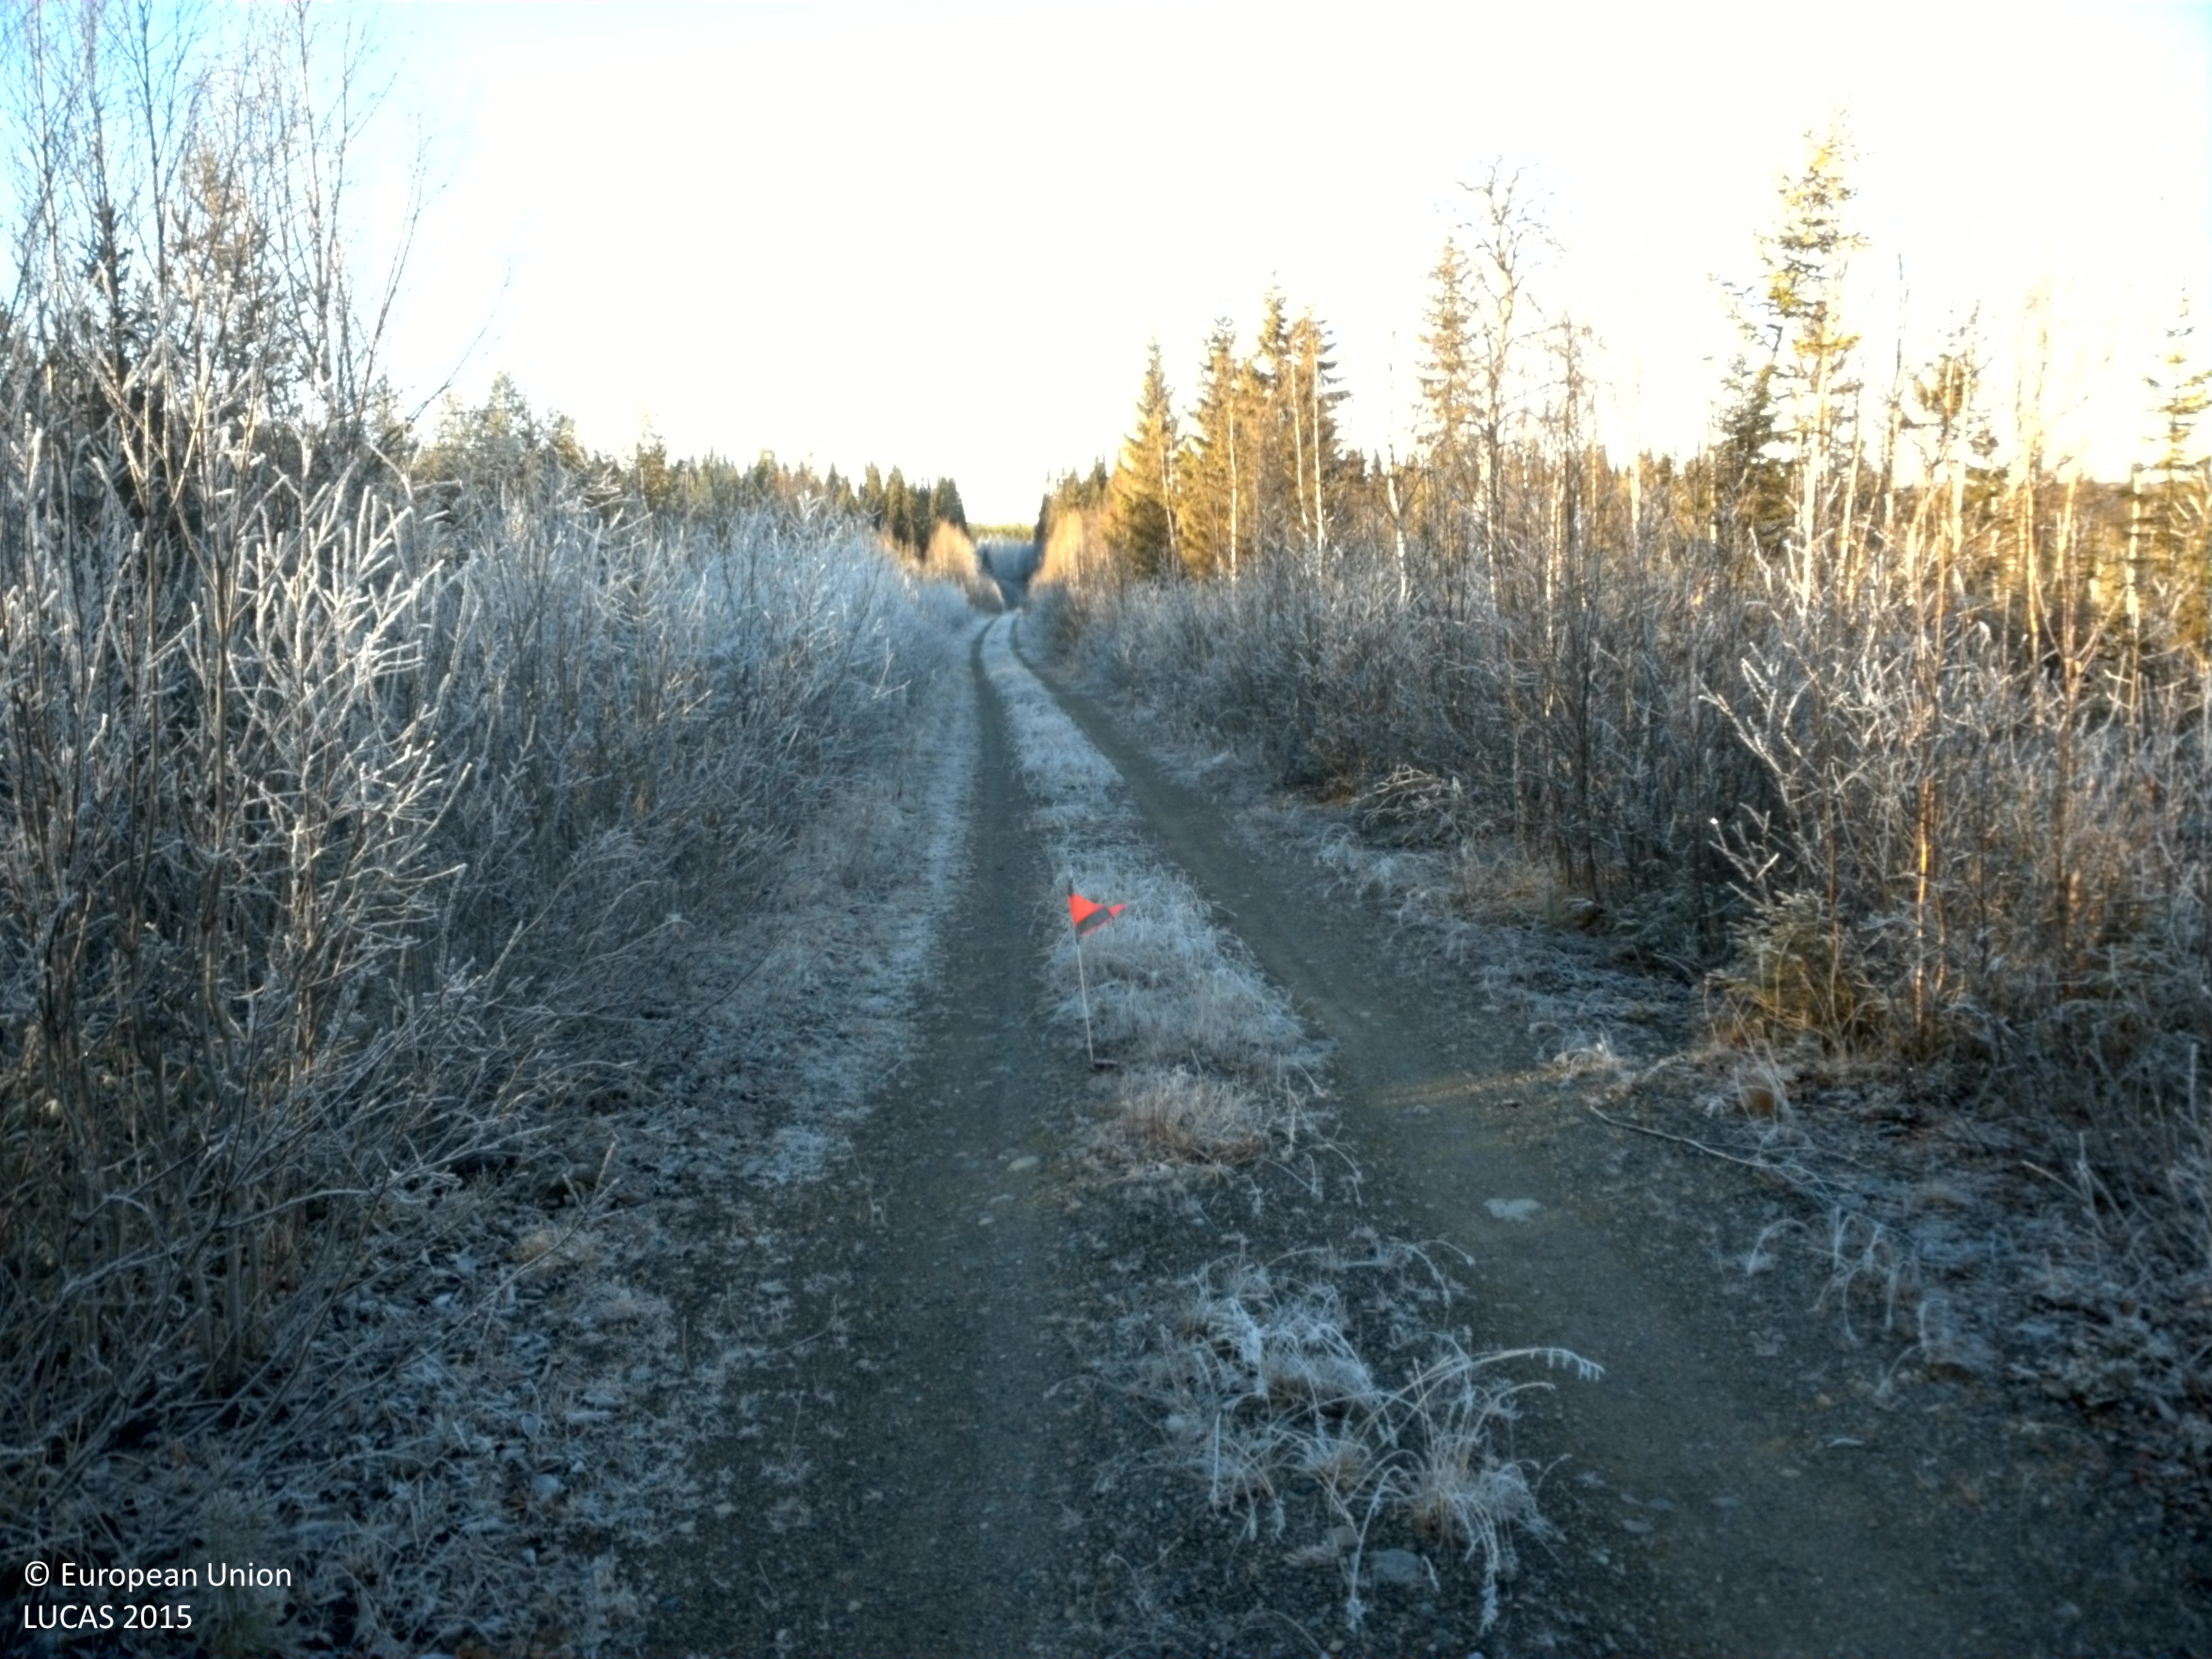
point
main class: Artificial land
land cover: Non built-up linear features
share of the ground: > 75 %
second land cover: Grassland without tree/shrub cover
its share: 10 - 25 %
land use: Road transport
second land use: Forestry
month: October
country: SE
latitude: 64.4406
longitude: 16.6363
